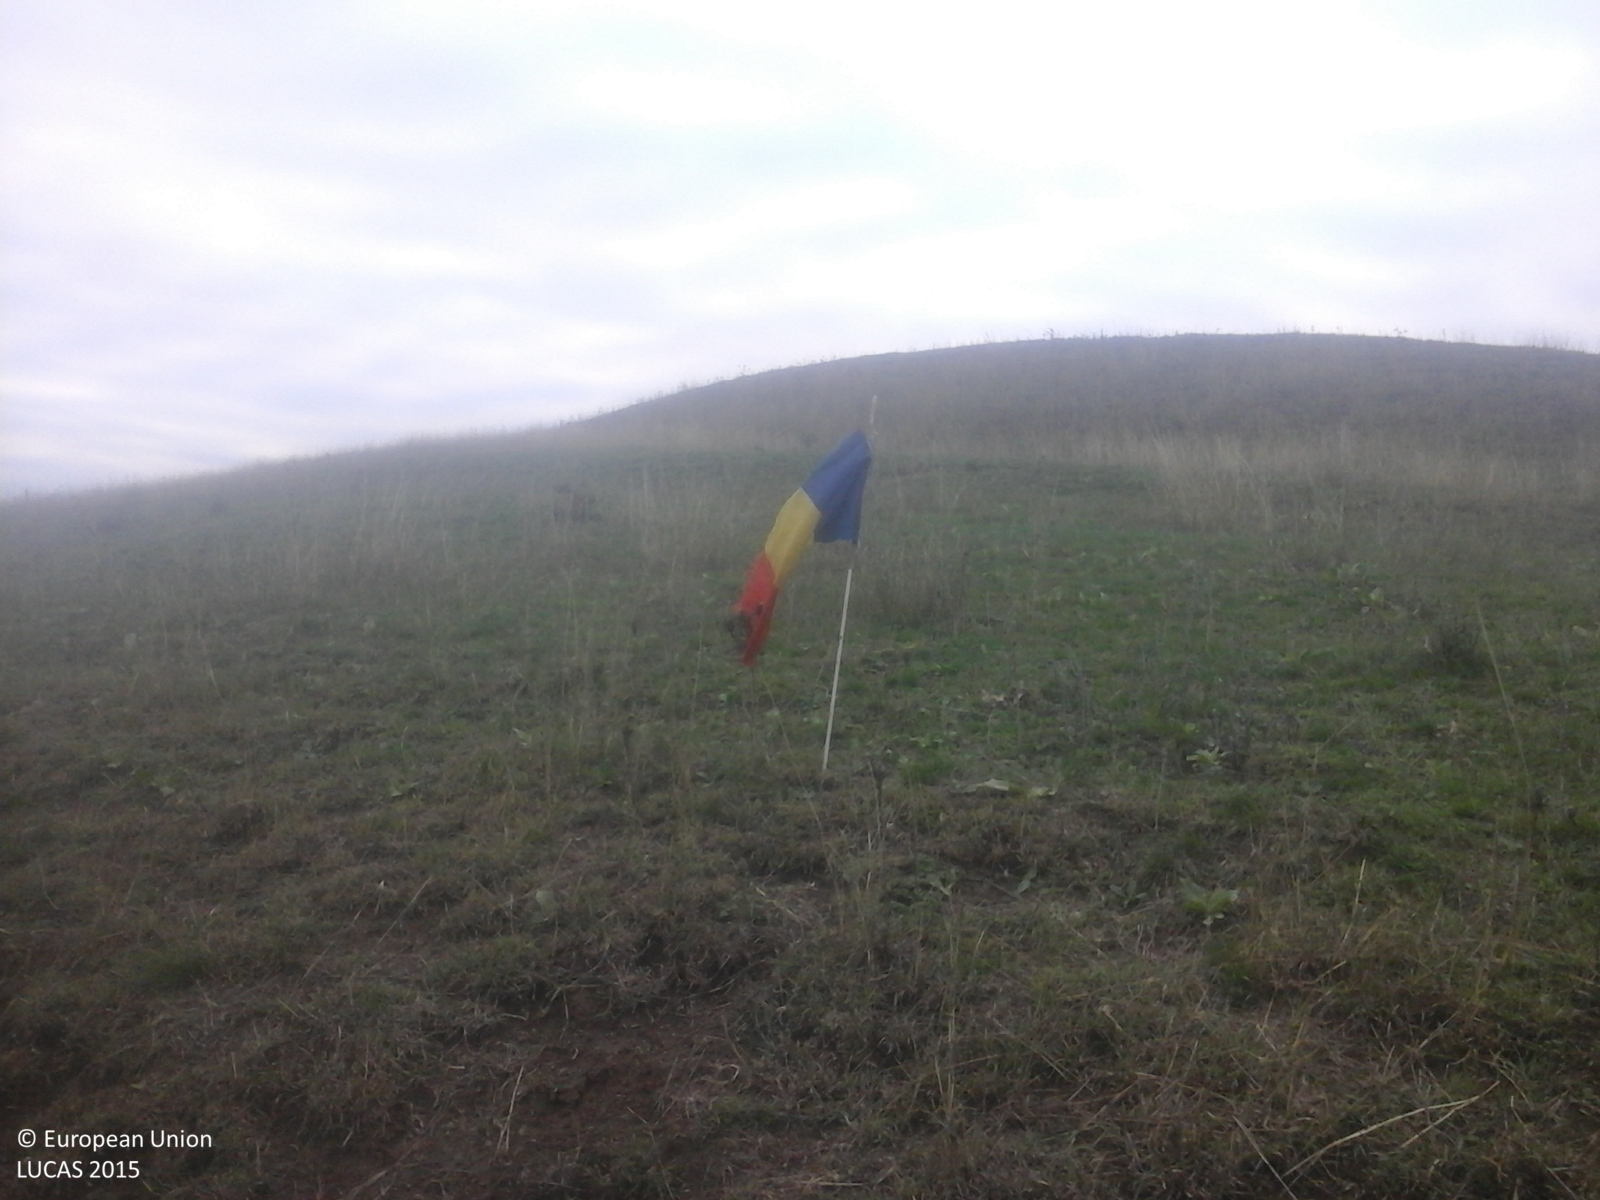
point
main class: Grassland
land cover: Grassland without tree/shrub cover
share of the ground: > 75 %
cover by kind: herbaceous plants 100 %
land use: Agriculture (excluding fallow land and kitchen gardens)
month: September
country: RO
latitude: 45.9150
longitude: 23.7474
